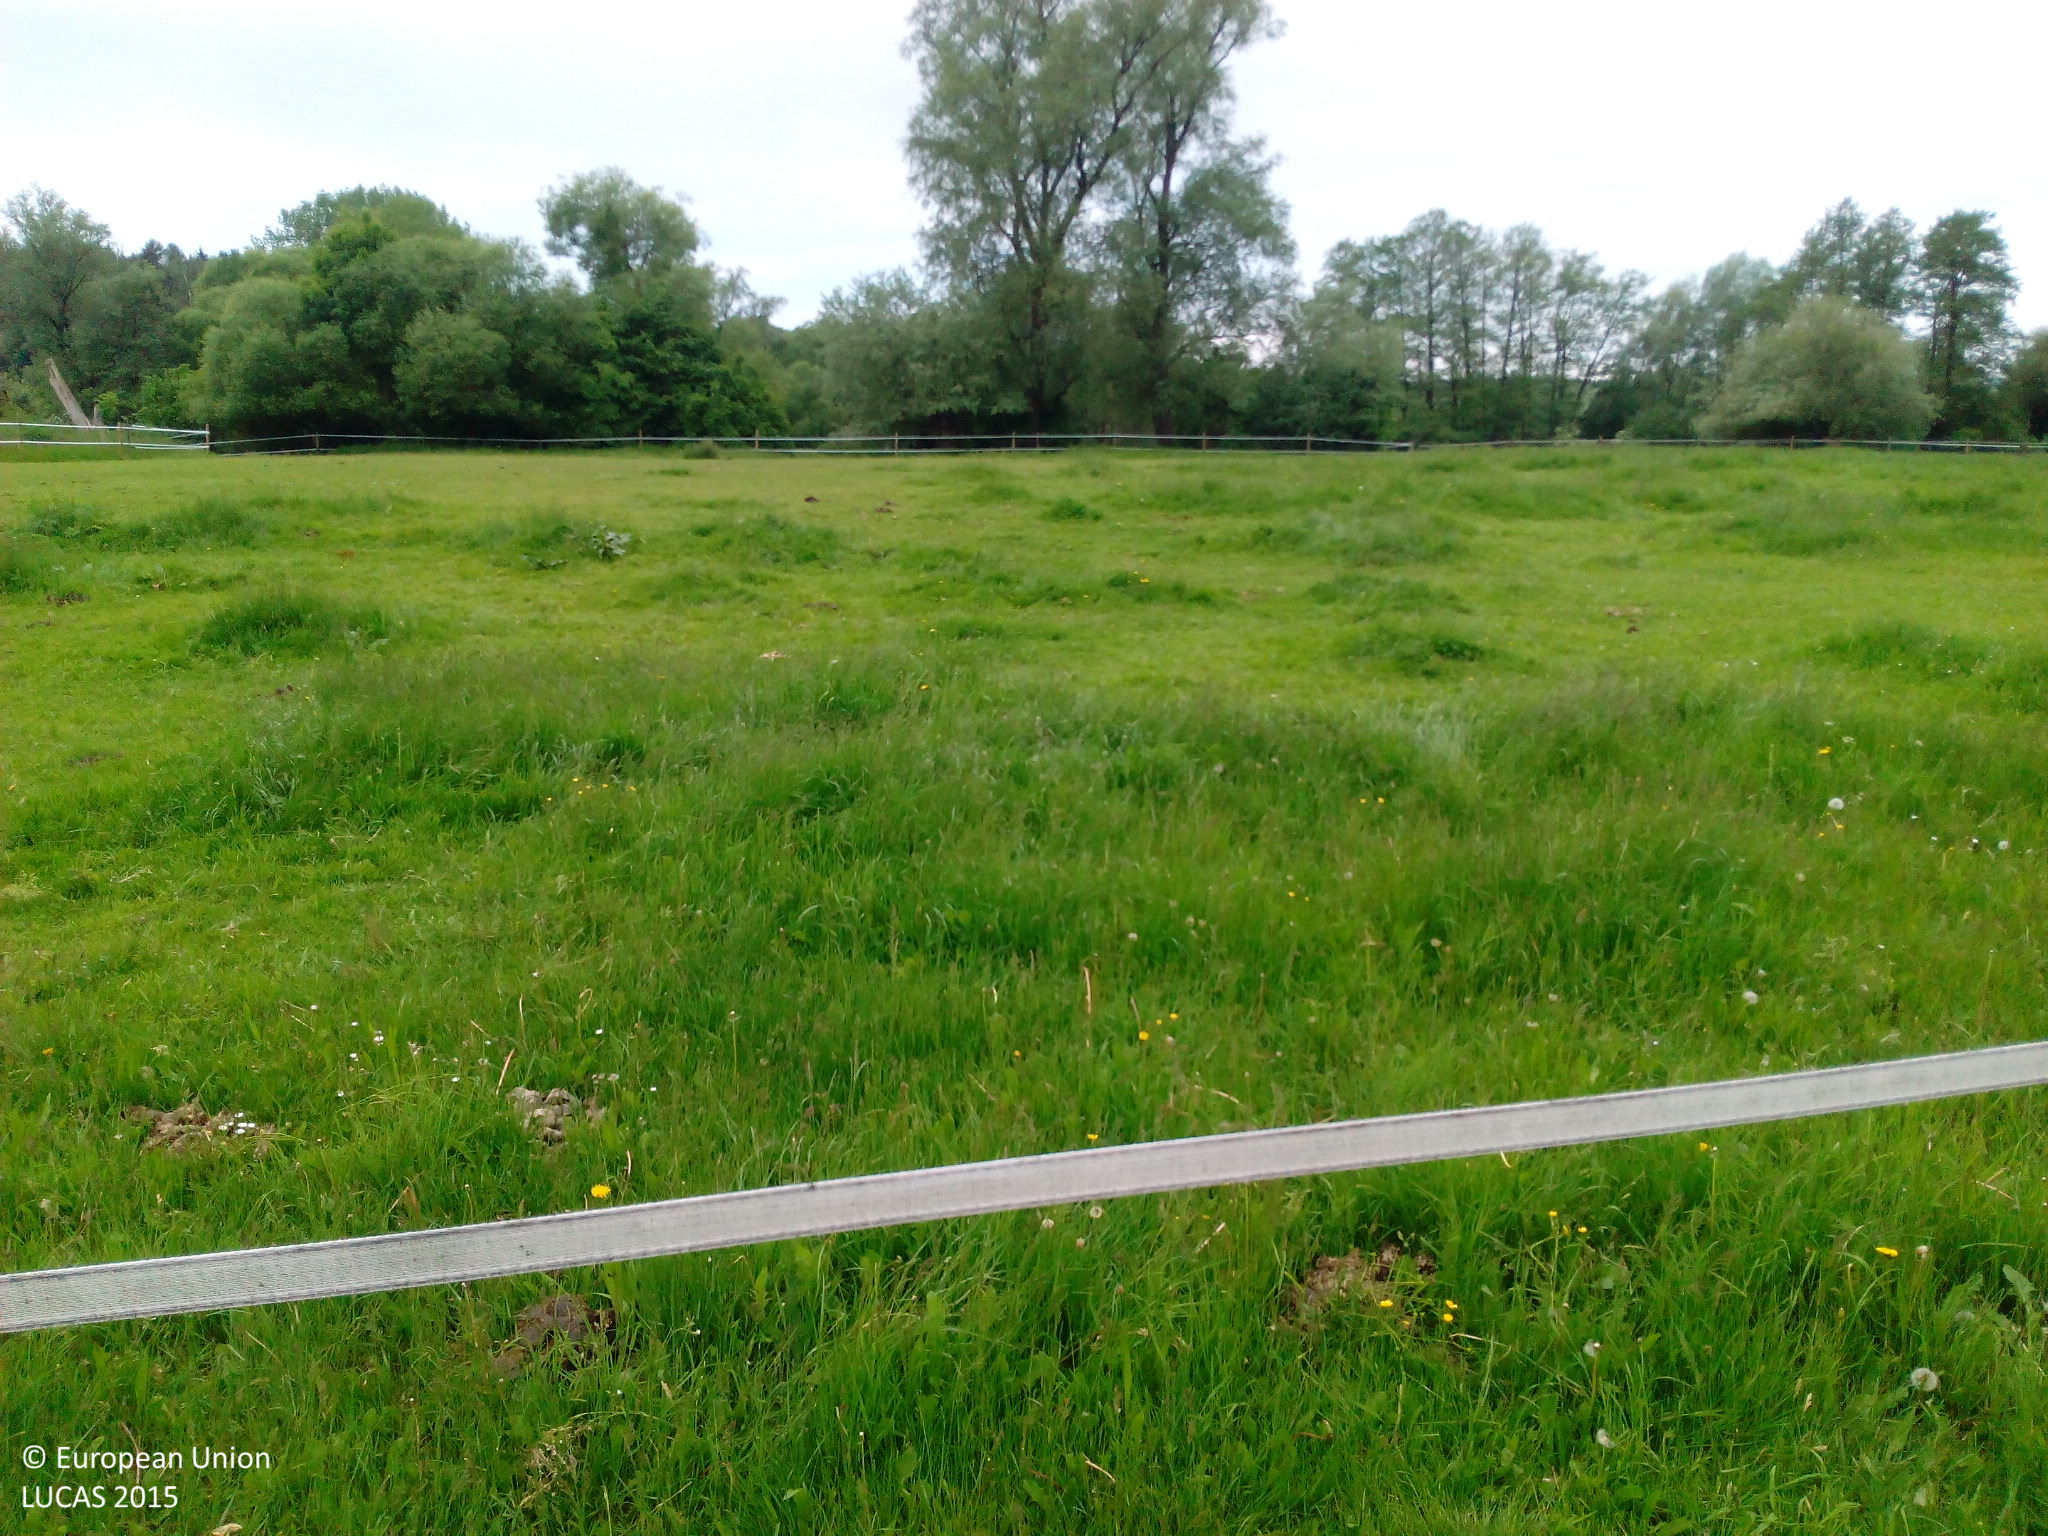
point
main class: Grassland
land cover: Grassland without tree/shrub cover
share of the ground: > 75 %
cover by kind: herbaceous plants 100 %
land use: Agriculture (excluding fallow land and kitchen gardens)
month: May
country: DE
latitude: 48.1333
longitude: 10.2551
